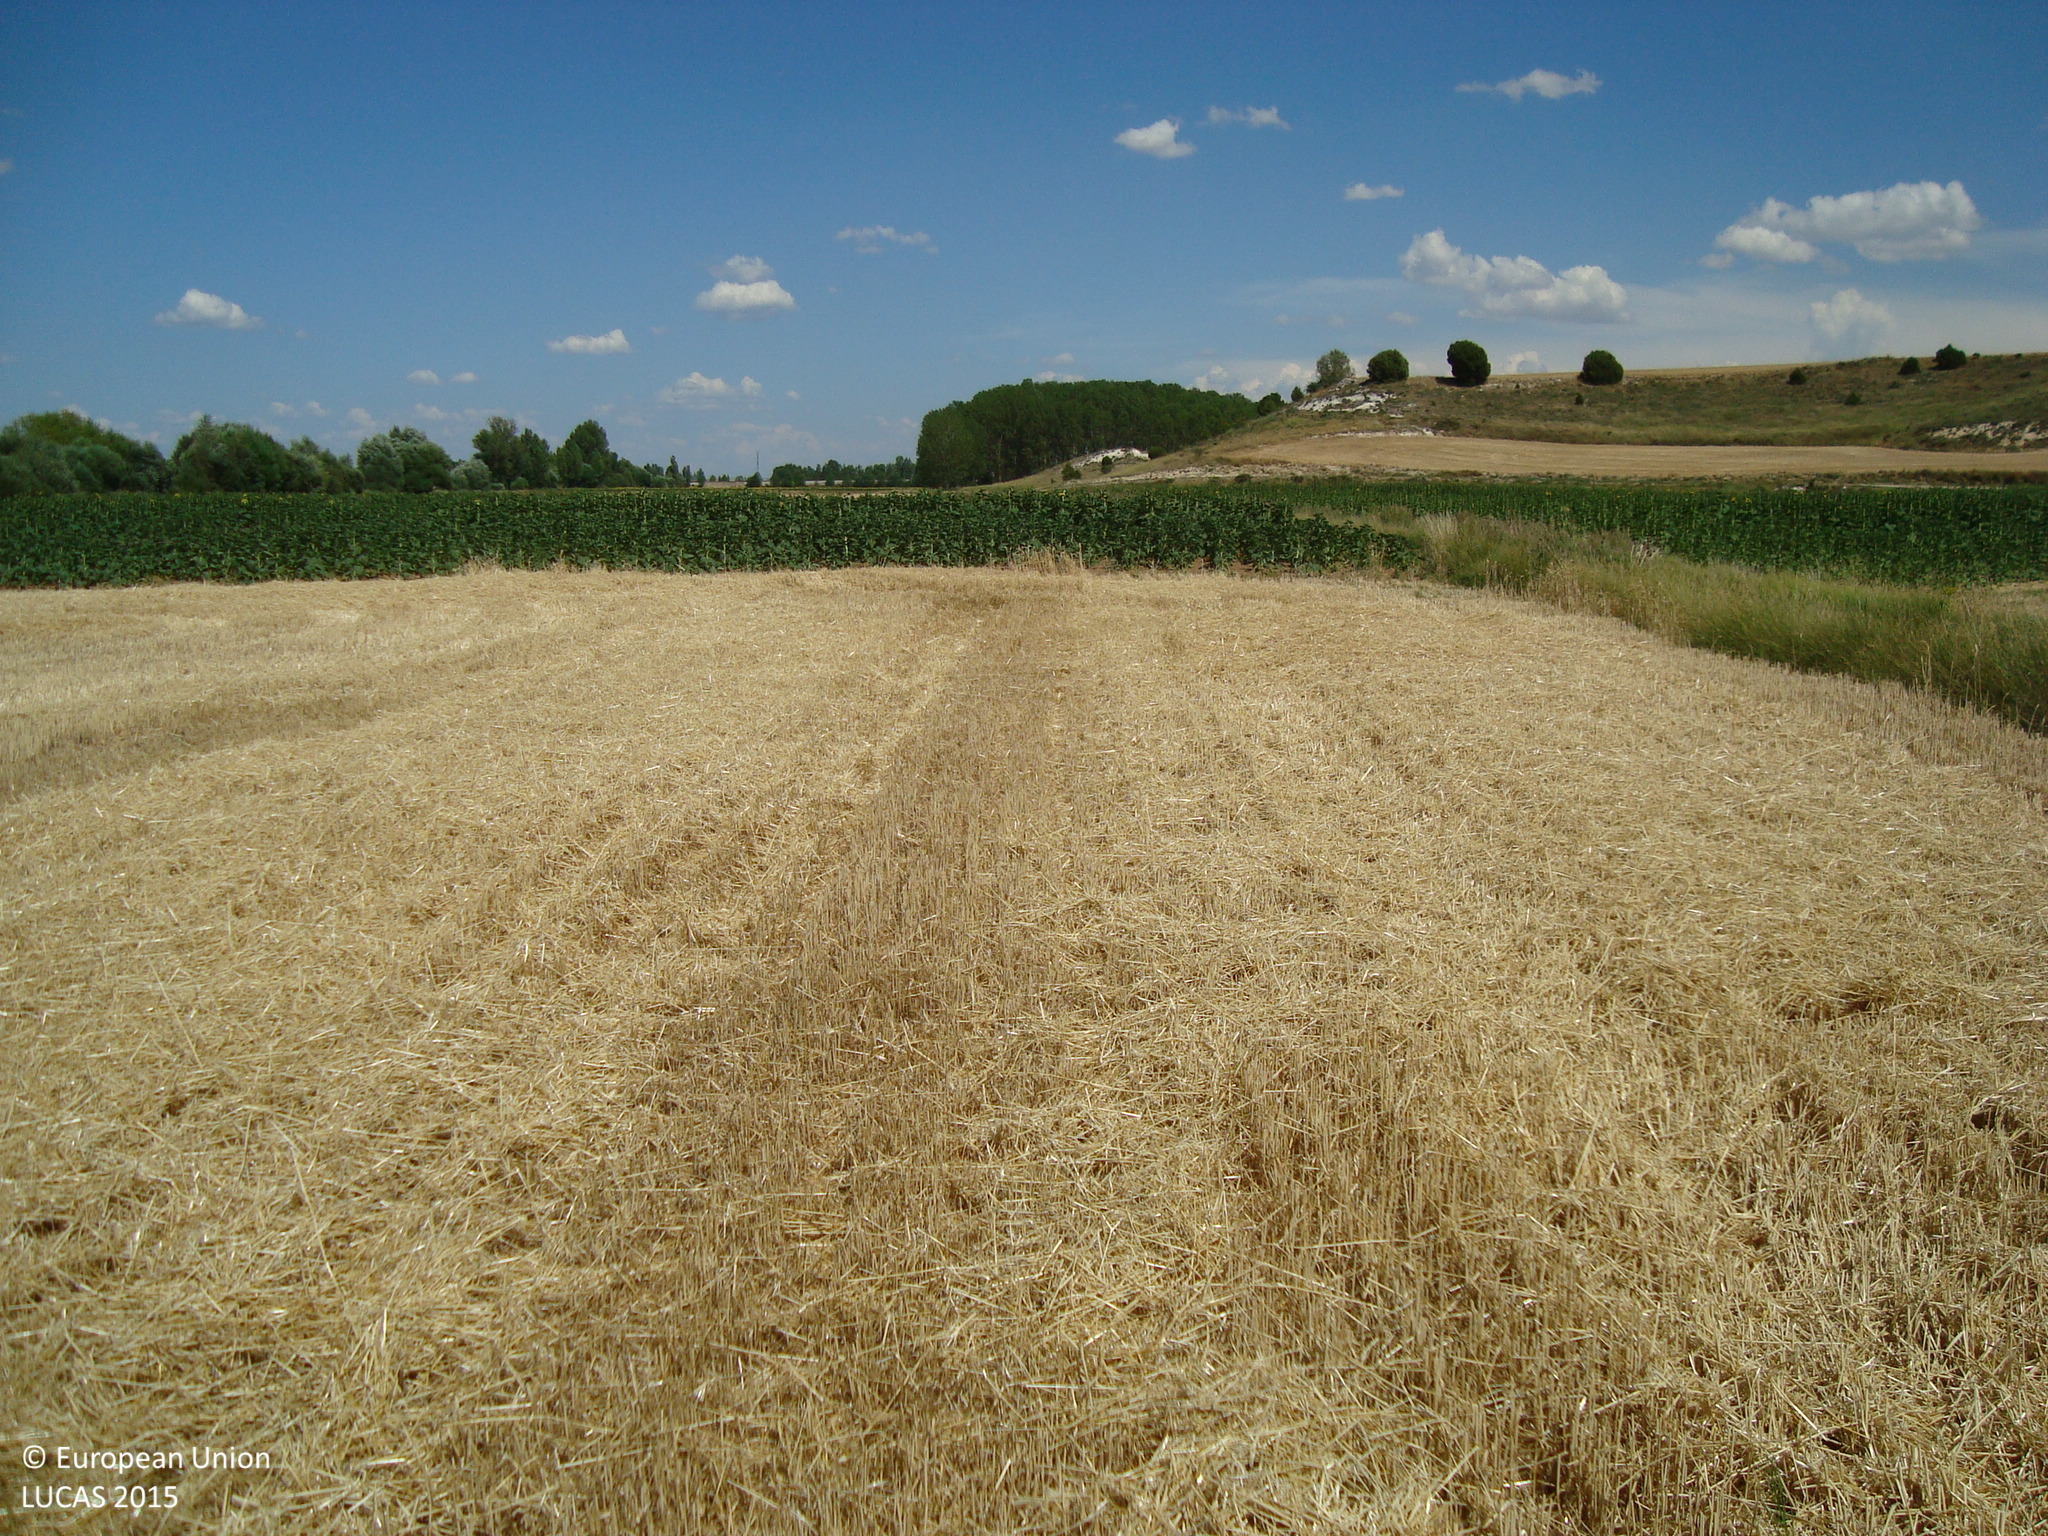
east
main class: Cropland
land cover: Common wheat
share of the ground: > 75 %
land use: Agriculture (excluding fallow land and kitchen gardens)
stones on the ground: < 10 %
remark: Harvested field
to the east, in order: Common wheat; Sunflower; Common wheat
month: July
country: ES
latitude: 41.8639
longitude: -3.7047
